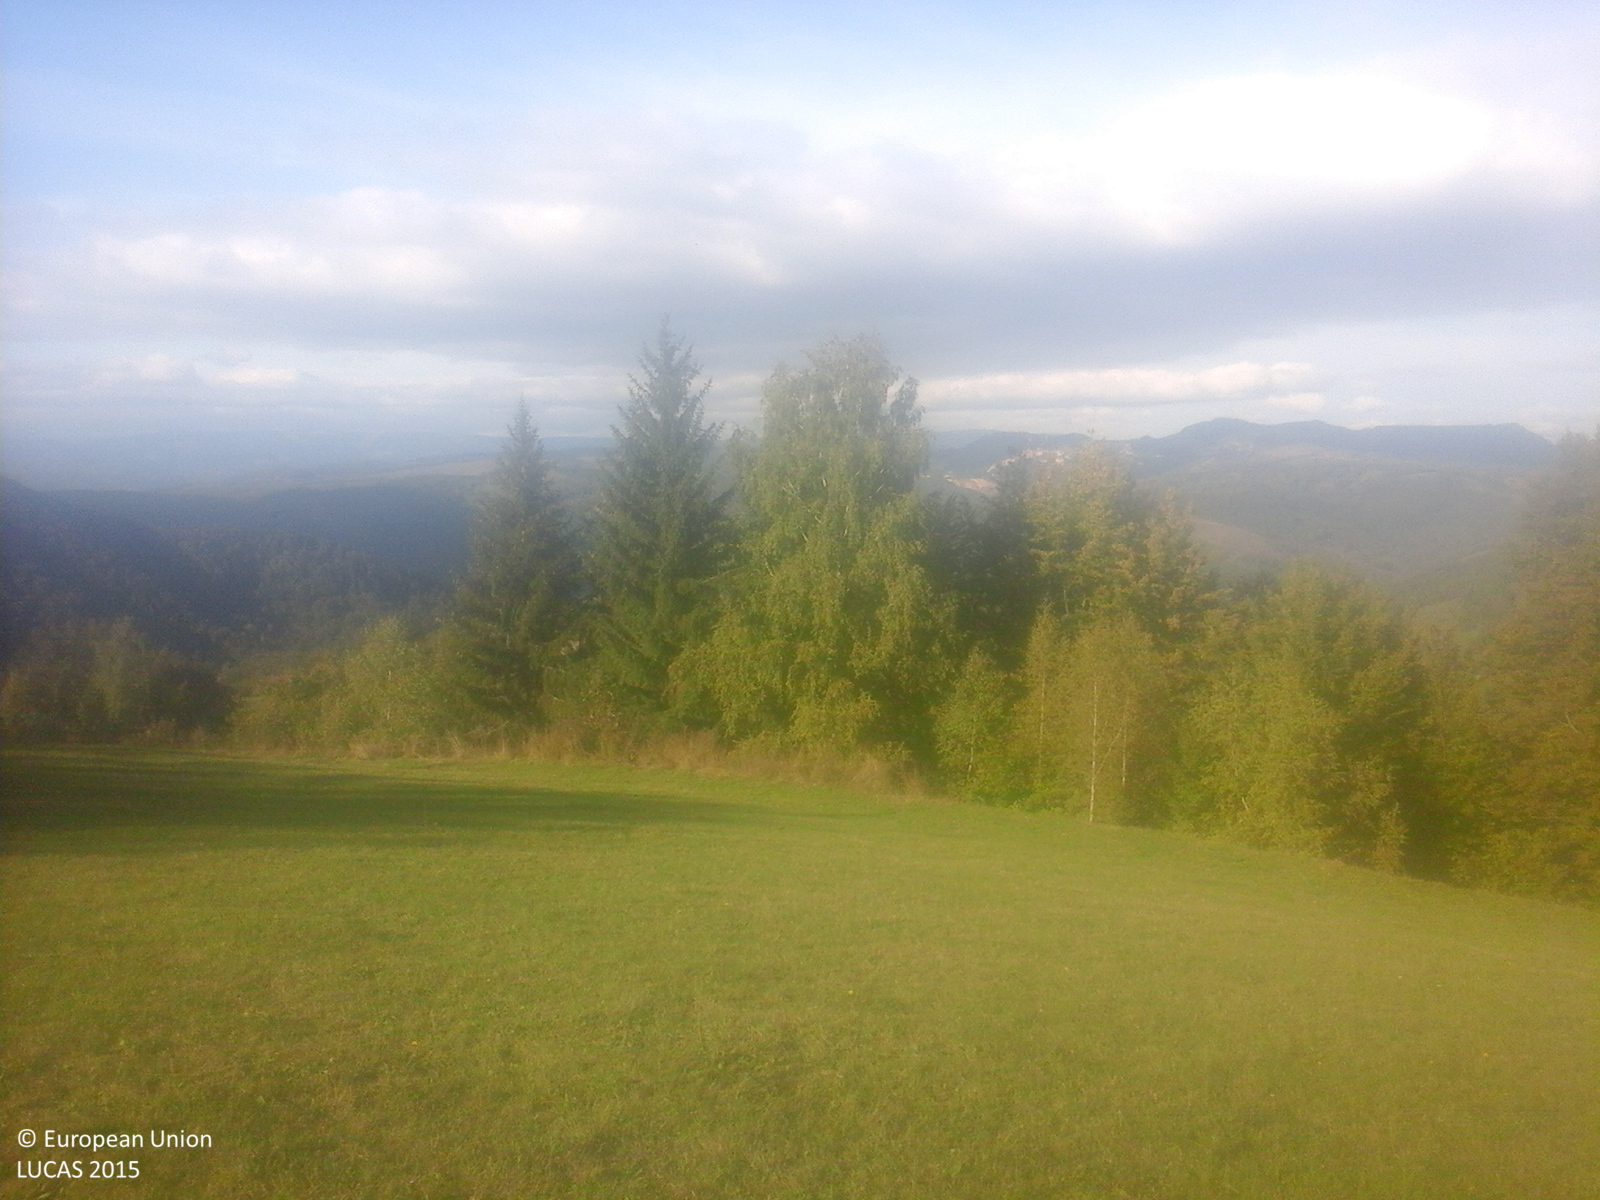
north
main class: Grassland
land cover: Grassland without tree/shrub cover
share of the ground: > 75 %
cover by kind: herbaceous plants 100 %
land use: Agriculture (excluding fallow land and kitchen gardens)
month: October
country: RO
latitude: 46.2355
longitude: 23.0915
